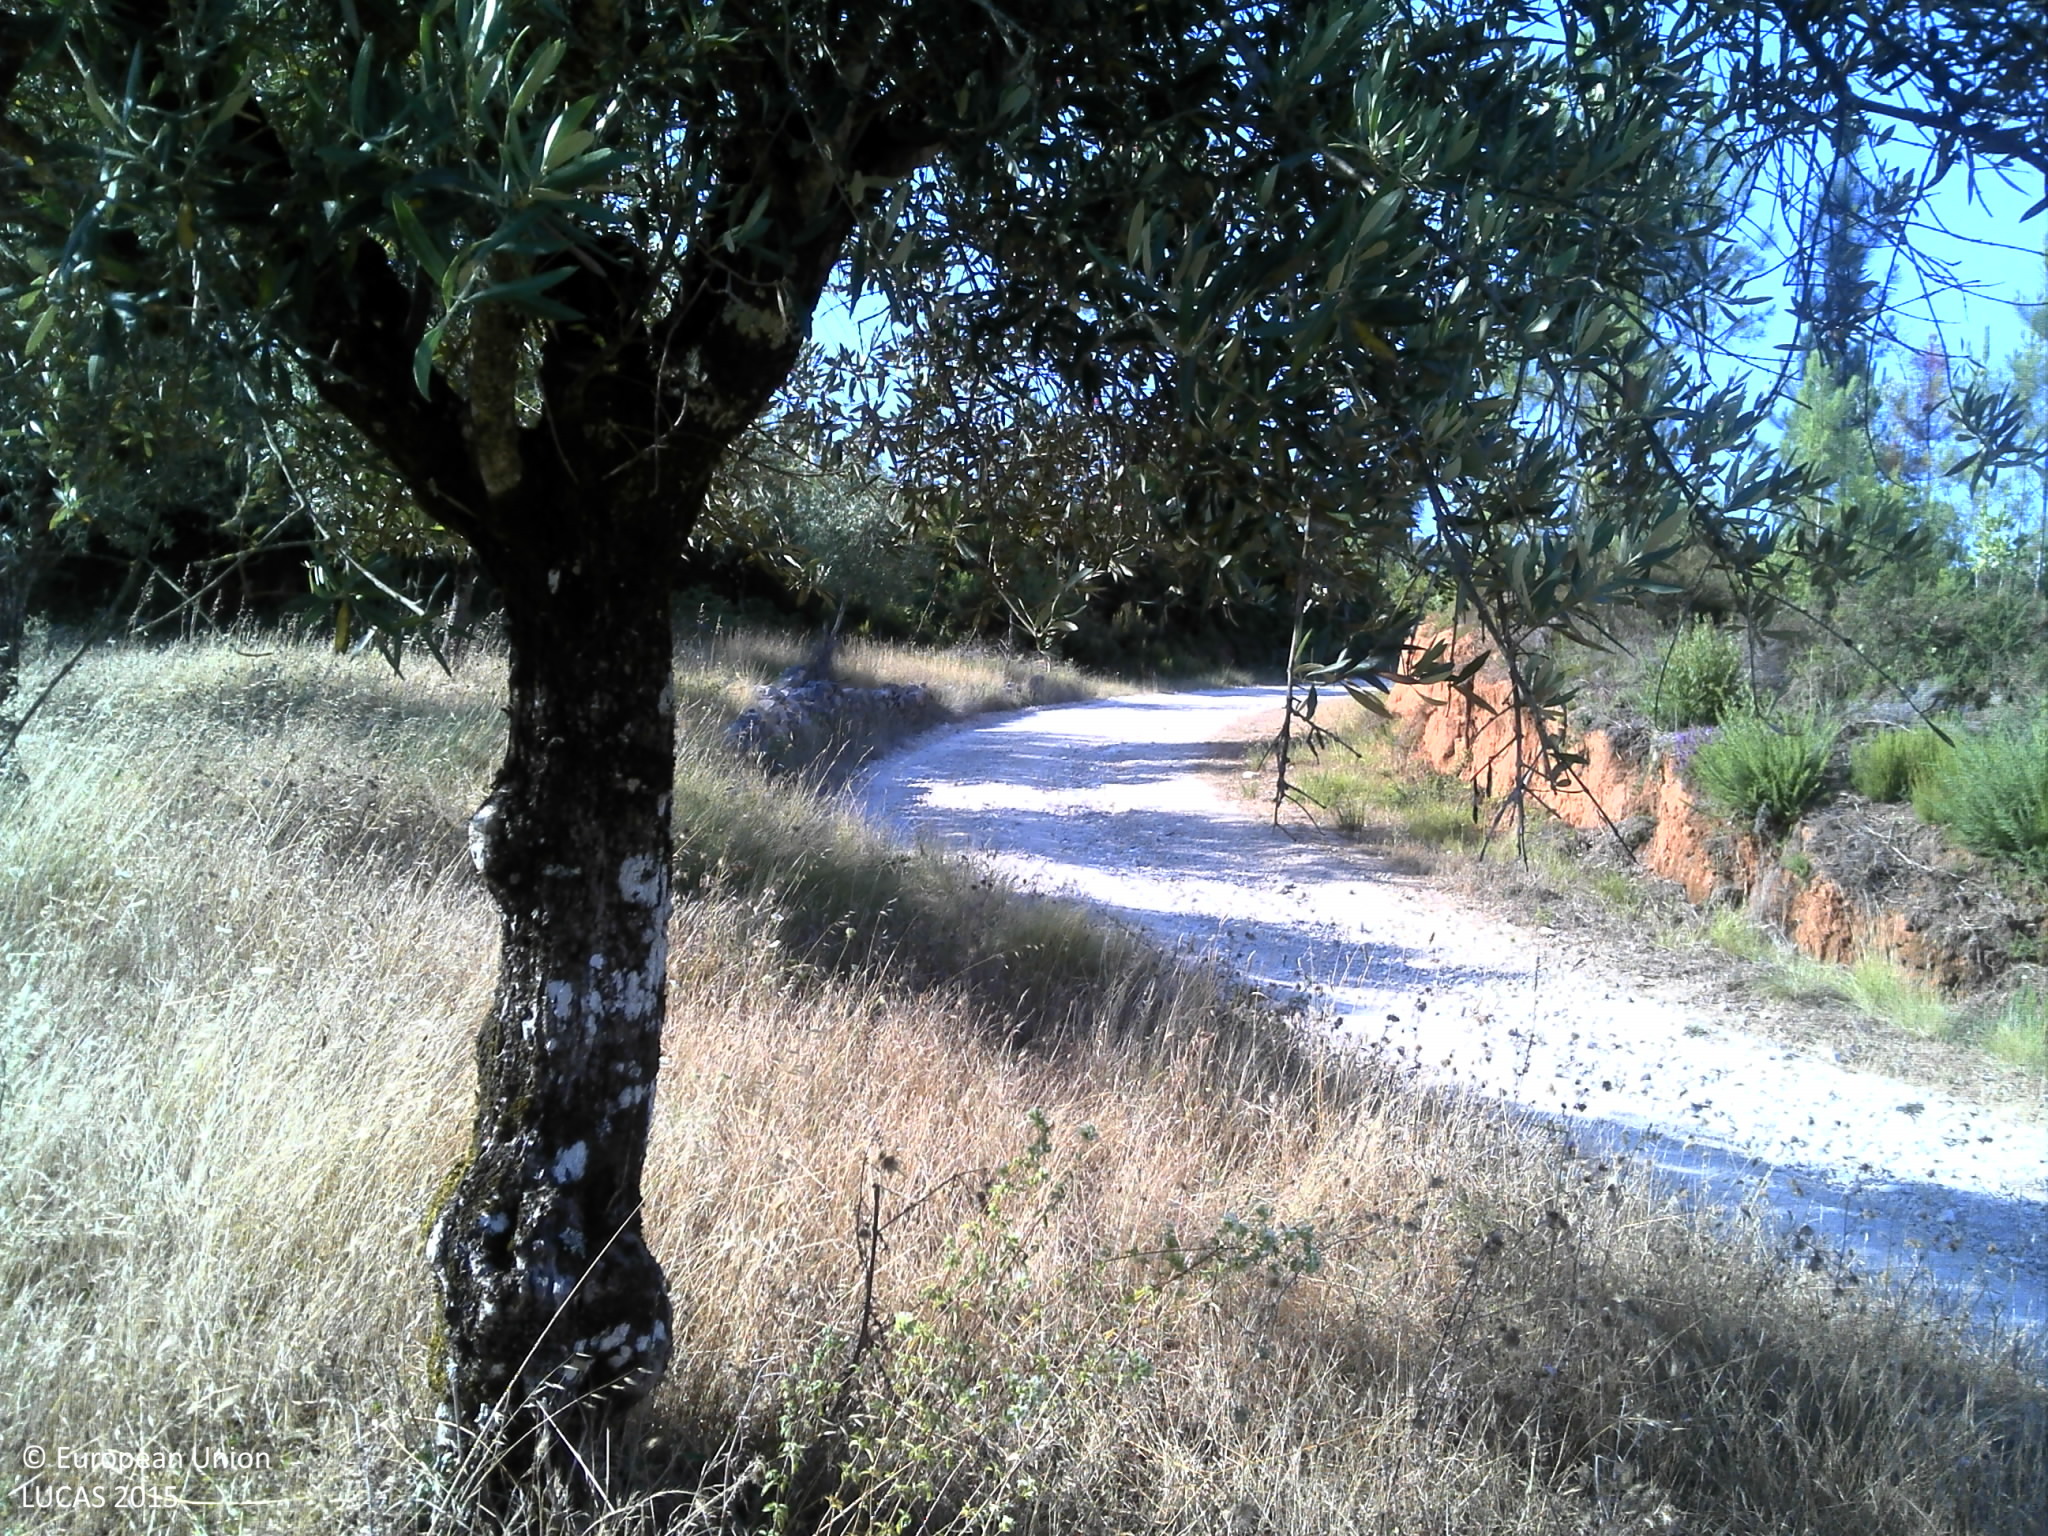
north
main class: Cropland
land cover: Olive groves
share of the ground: 10 - 25 %
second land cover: Grassland without tree/shrub cover
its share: > 75 %
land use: Agriculture (excluding fallow land and kitchen gardens)
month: July
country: PT
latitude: 39.9840
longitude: -8.5264
